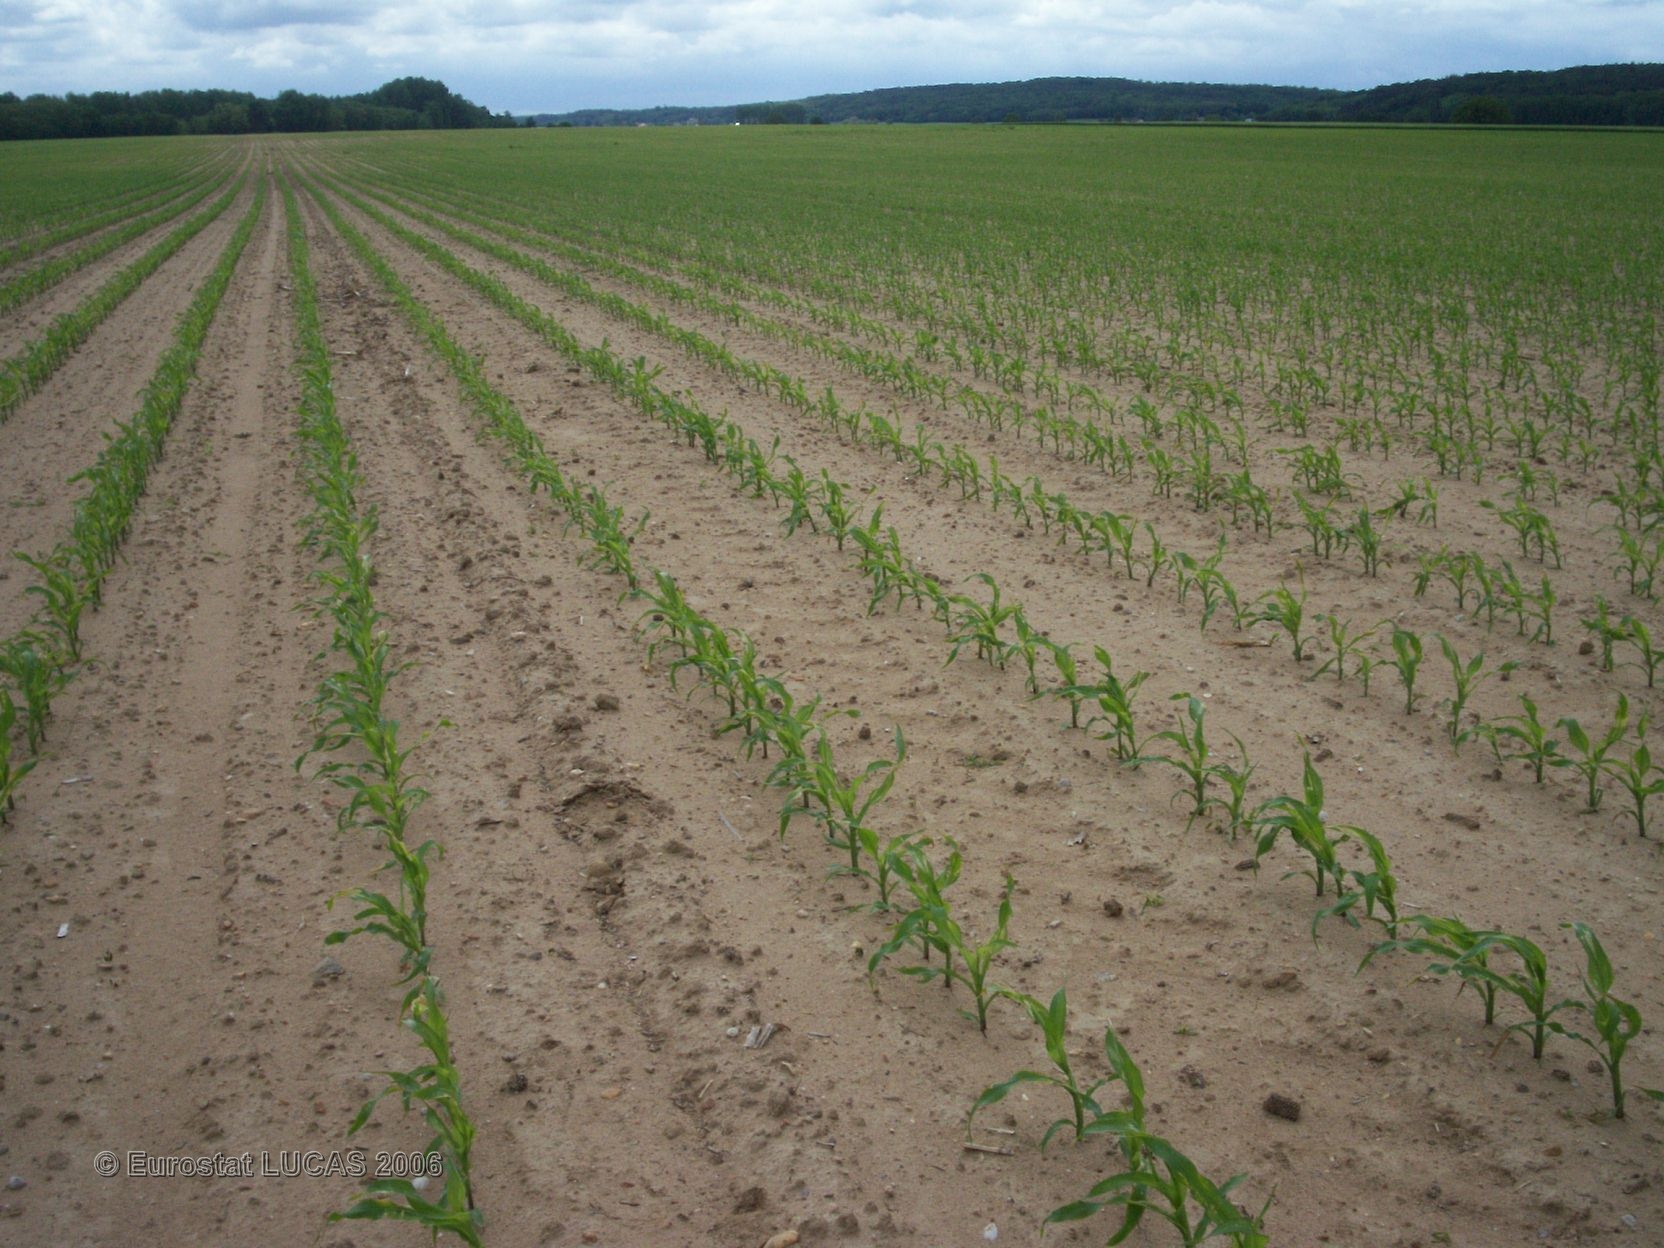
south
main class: Cropland
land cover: Maize
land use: Agriculture (excluding fallow land and kitchen gardens)
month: May
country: FR
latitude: 46.7115
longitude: 0.5507
